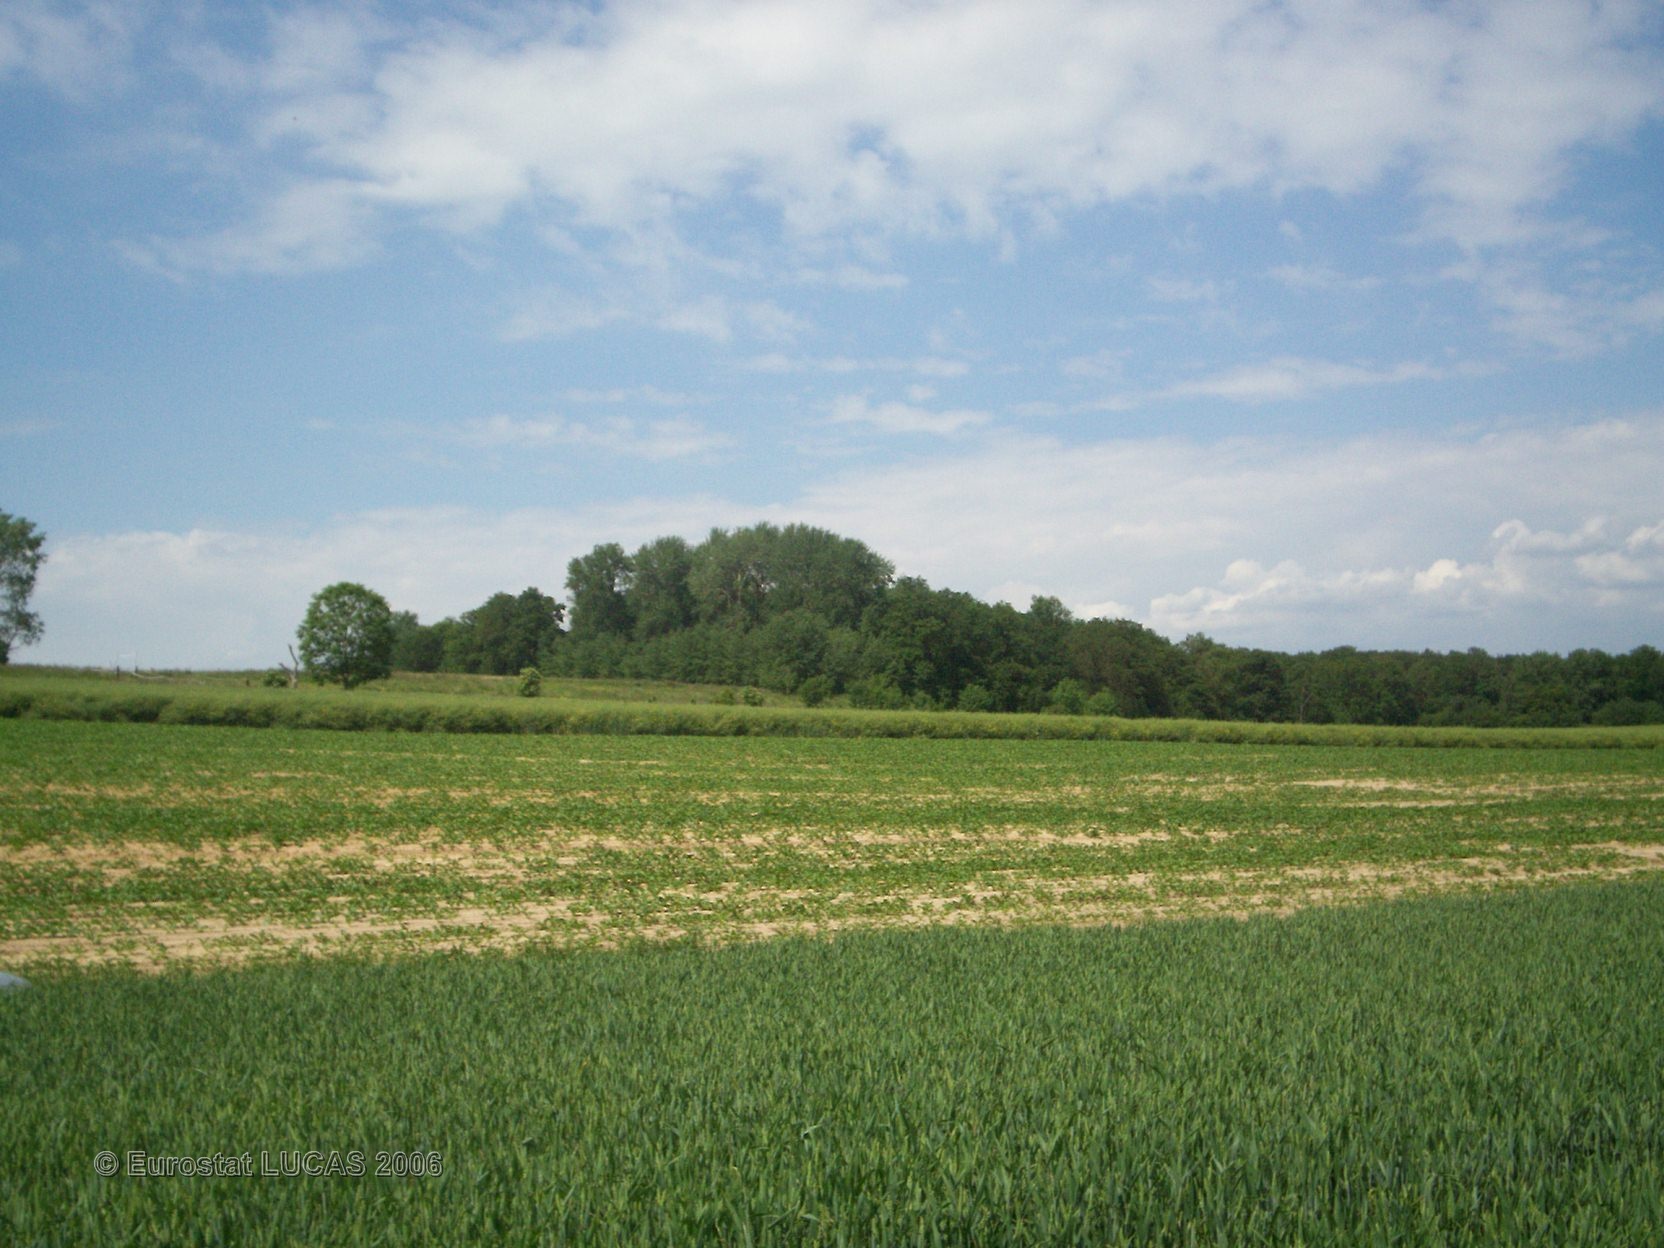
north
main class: Cropland
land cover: Common wheat
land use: Agriculture (excluding fallow land and kitchen gardens)
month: June
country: FR
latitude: 49.4100
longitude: 2.7258
